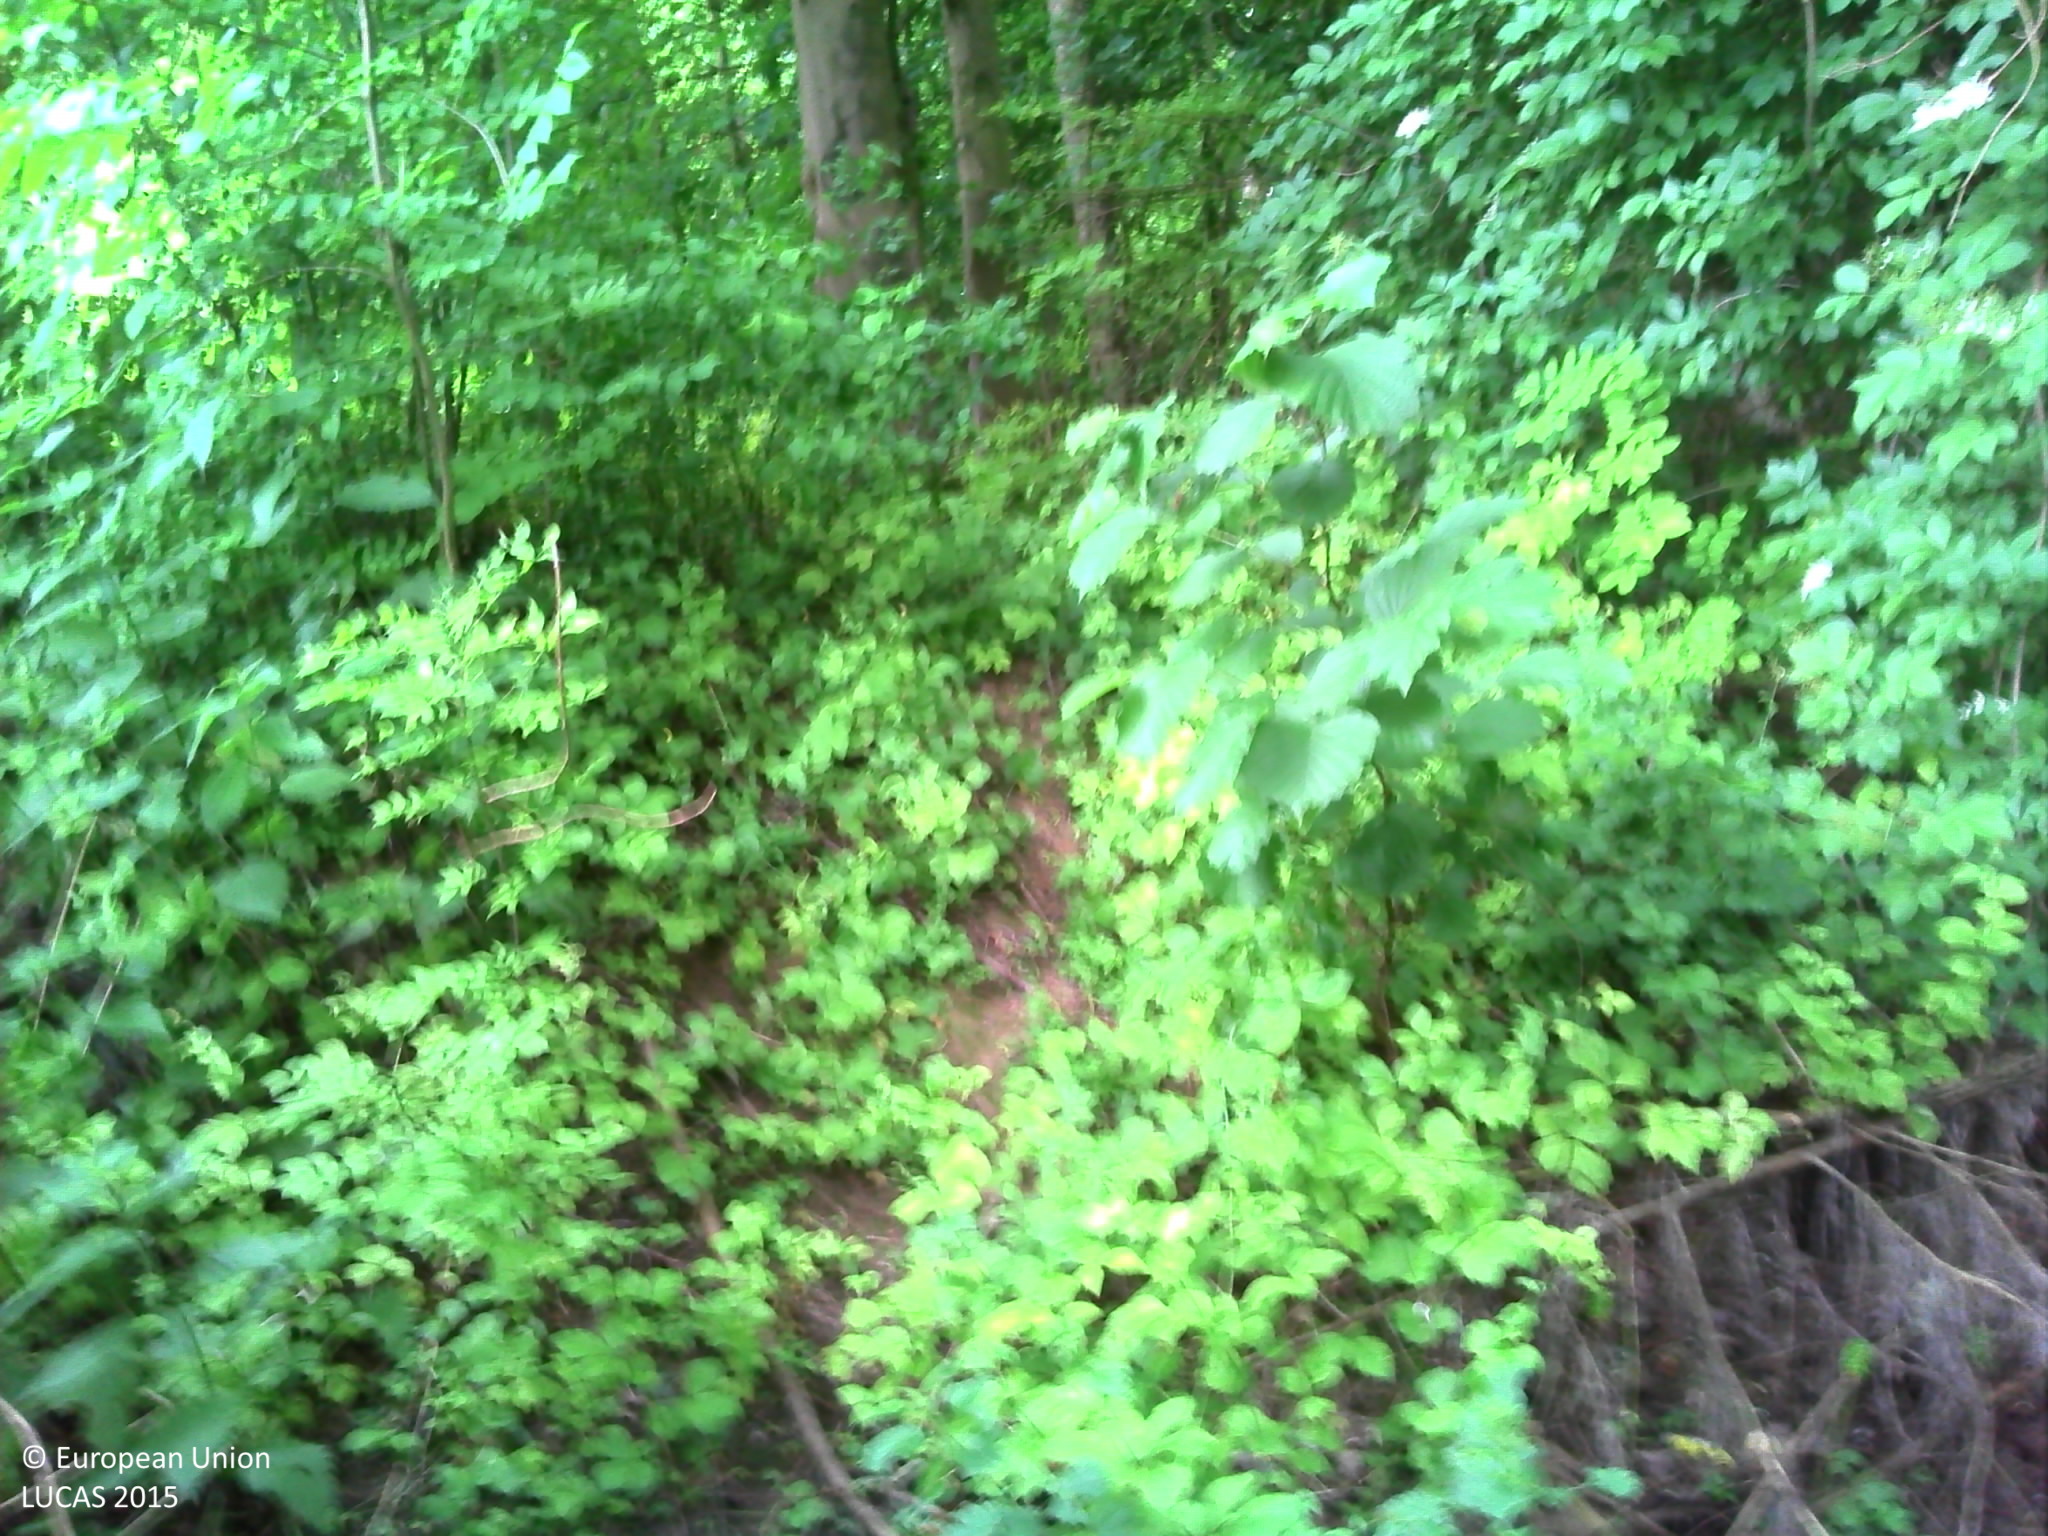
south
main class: Grassland
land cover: Grassland with sparse tree/shrub cover
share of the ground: > 75 %
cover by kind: herbaceous plants 95 %, broadleaved forest trees 5 %
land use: Residential
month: June
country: BE
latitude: 50.4206
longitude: 3.9560
